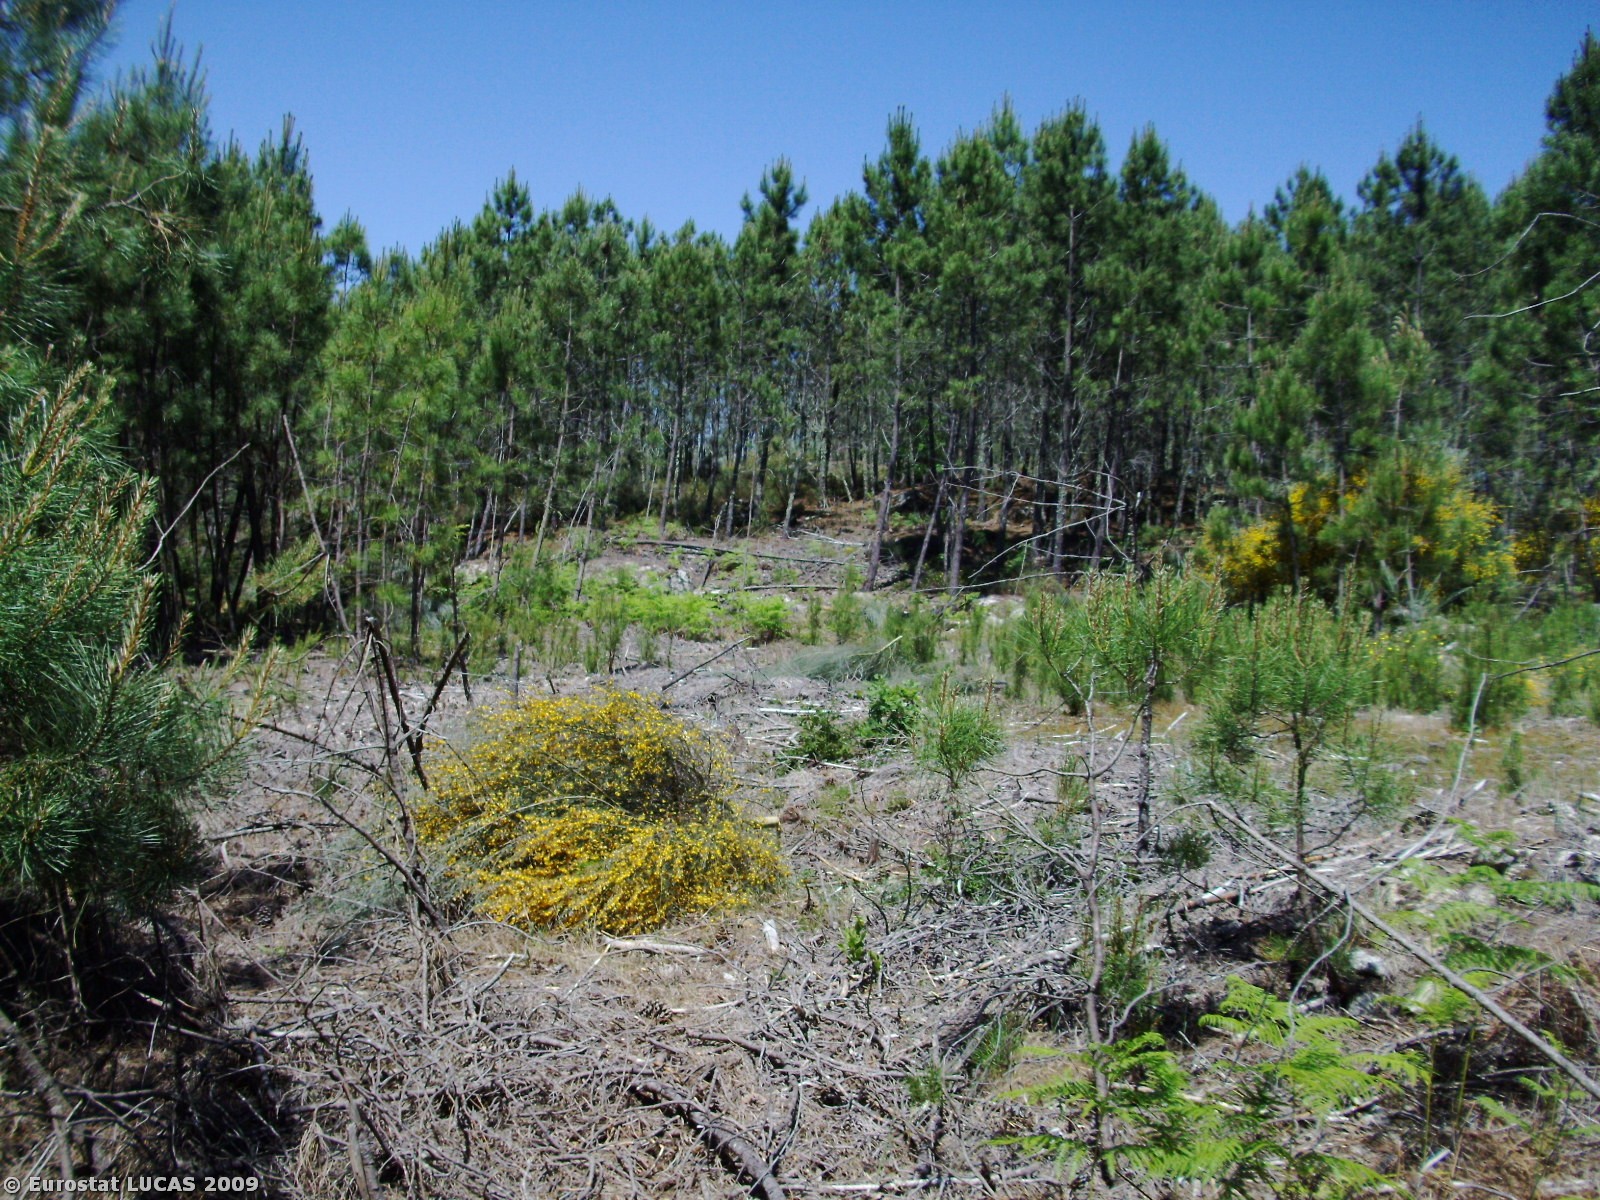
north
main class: Woodland
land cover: Coniferous woodland
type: coniferous forest of the mediterranean region
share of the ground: 10 - 25 %
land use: Forestry
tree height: > 5 m
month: May
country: PT
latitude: 40.7453
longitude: -7.5128
